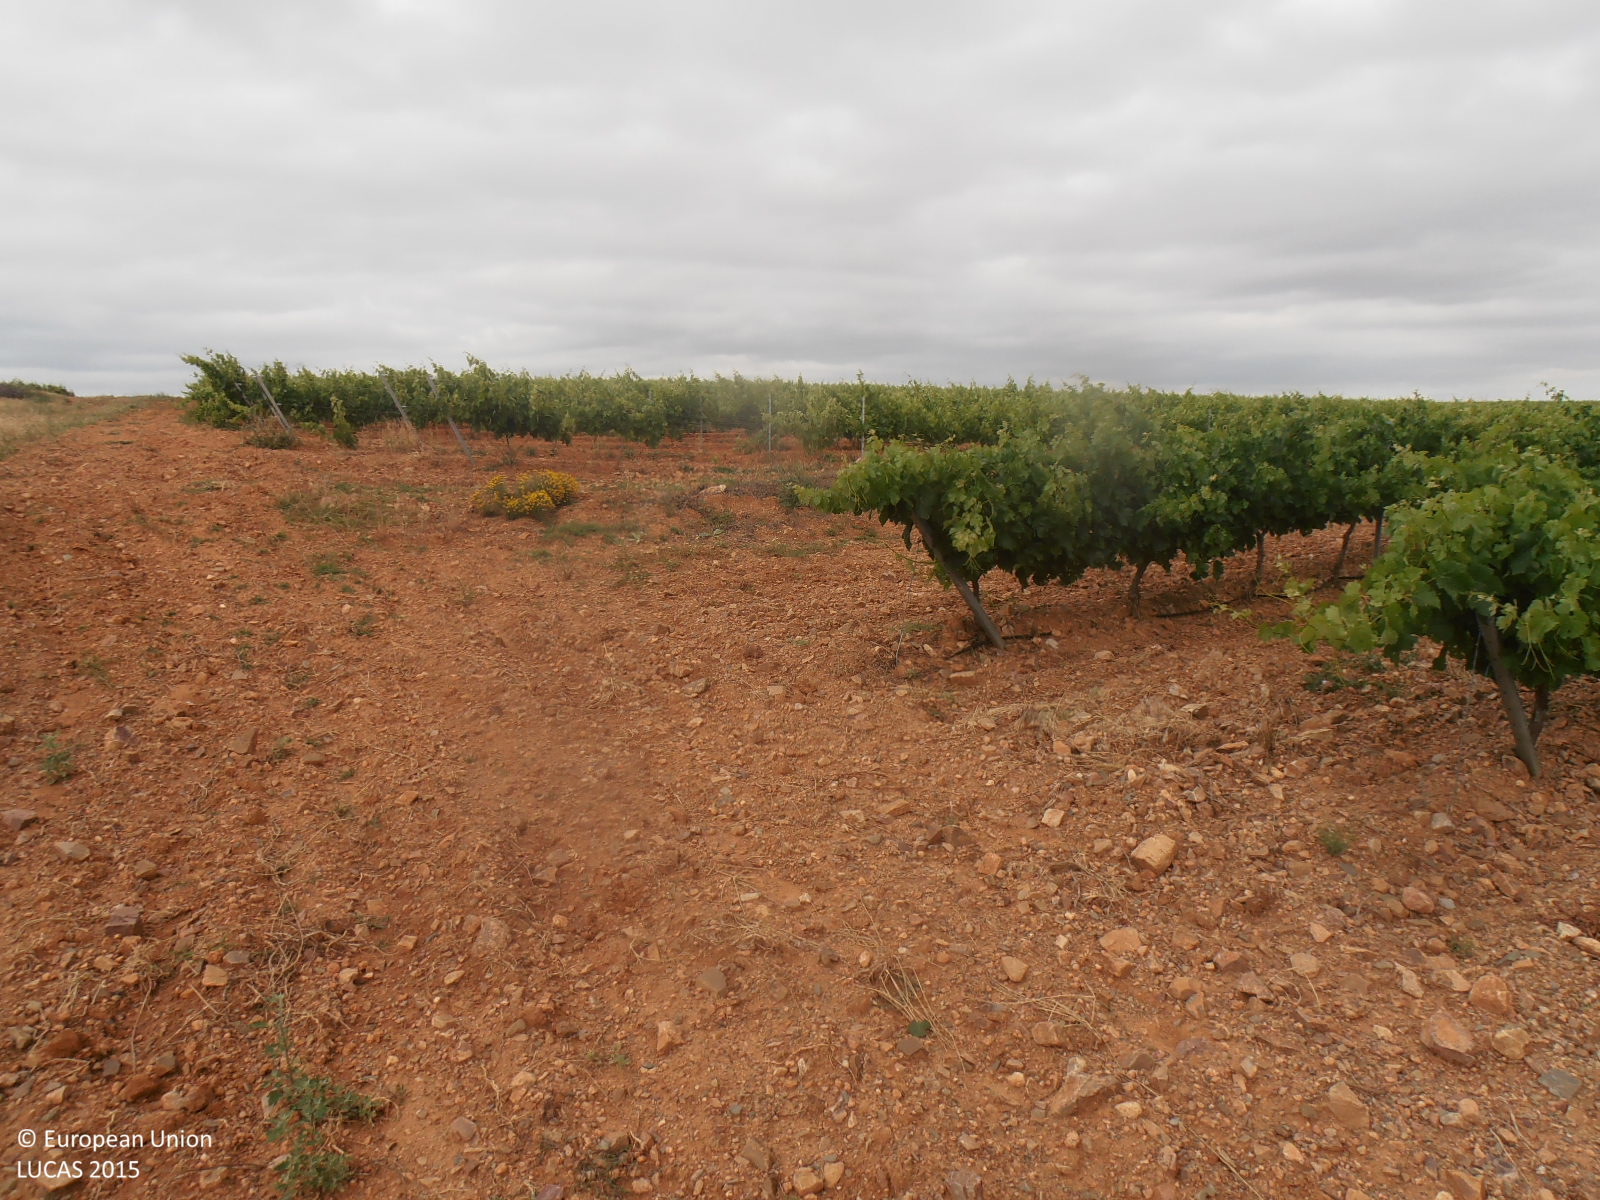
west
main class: Cropland
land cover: Vineyards
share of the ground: 25 - 50 %
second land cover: Other bare soil
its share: > 75 %
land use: Agriculture (excluding fallow land and kitchen gardens)
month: June
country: ES
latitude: 41.3033
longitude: -1.1880
